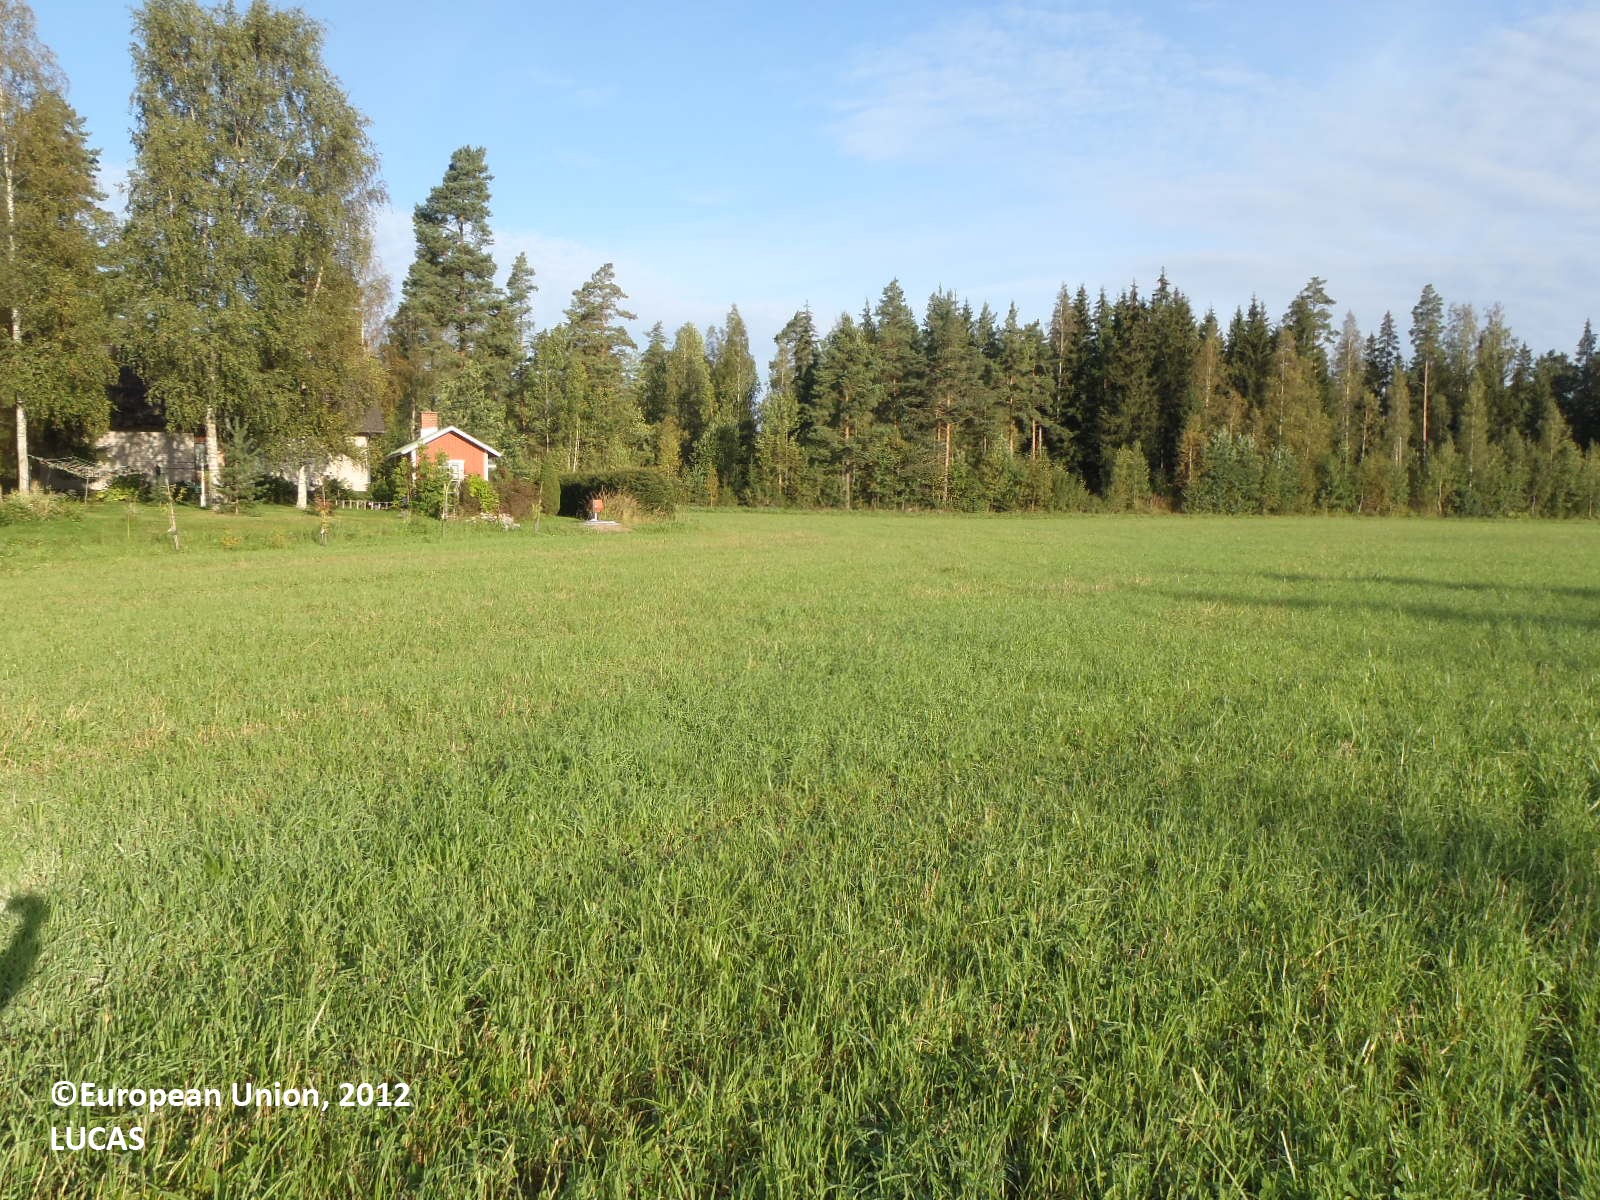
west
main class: Cropland
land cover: Temporary grasslands
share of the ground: > 75 %
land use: Agriculture (excluding fallow land and kitchen gardens)
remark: Harvested field
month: August
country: FI
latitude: 60.8081
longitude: 22.5117
